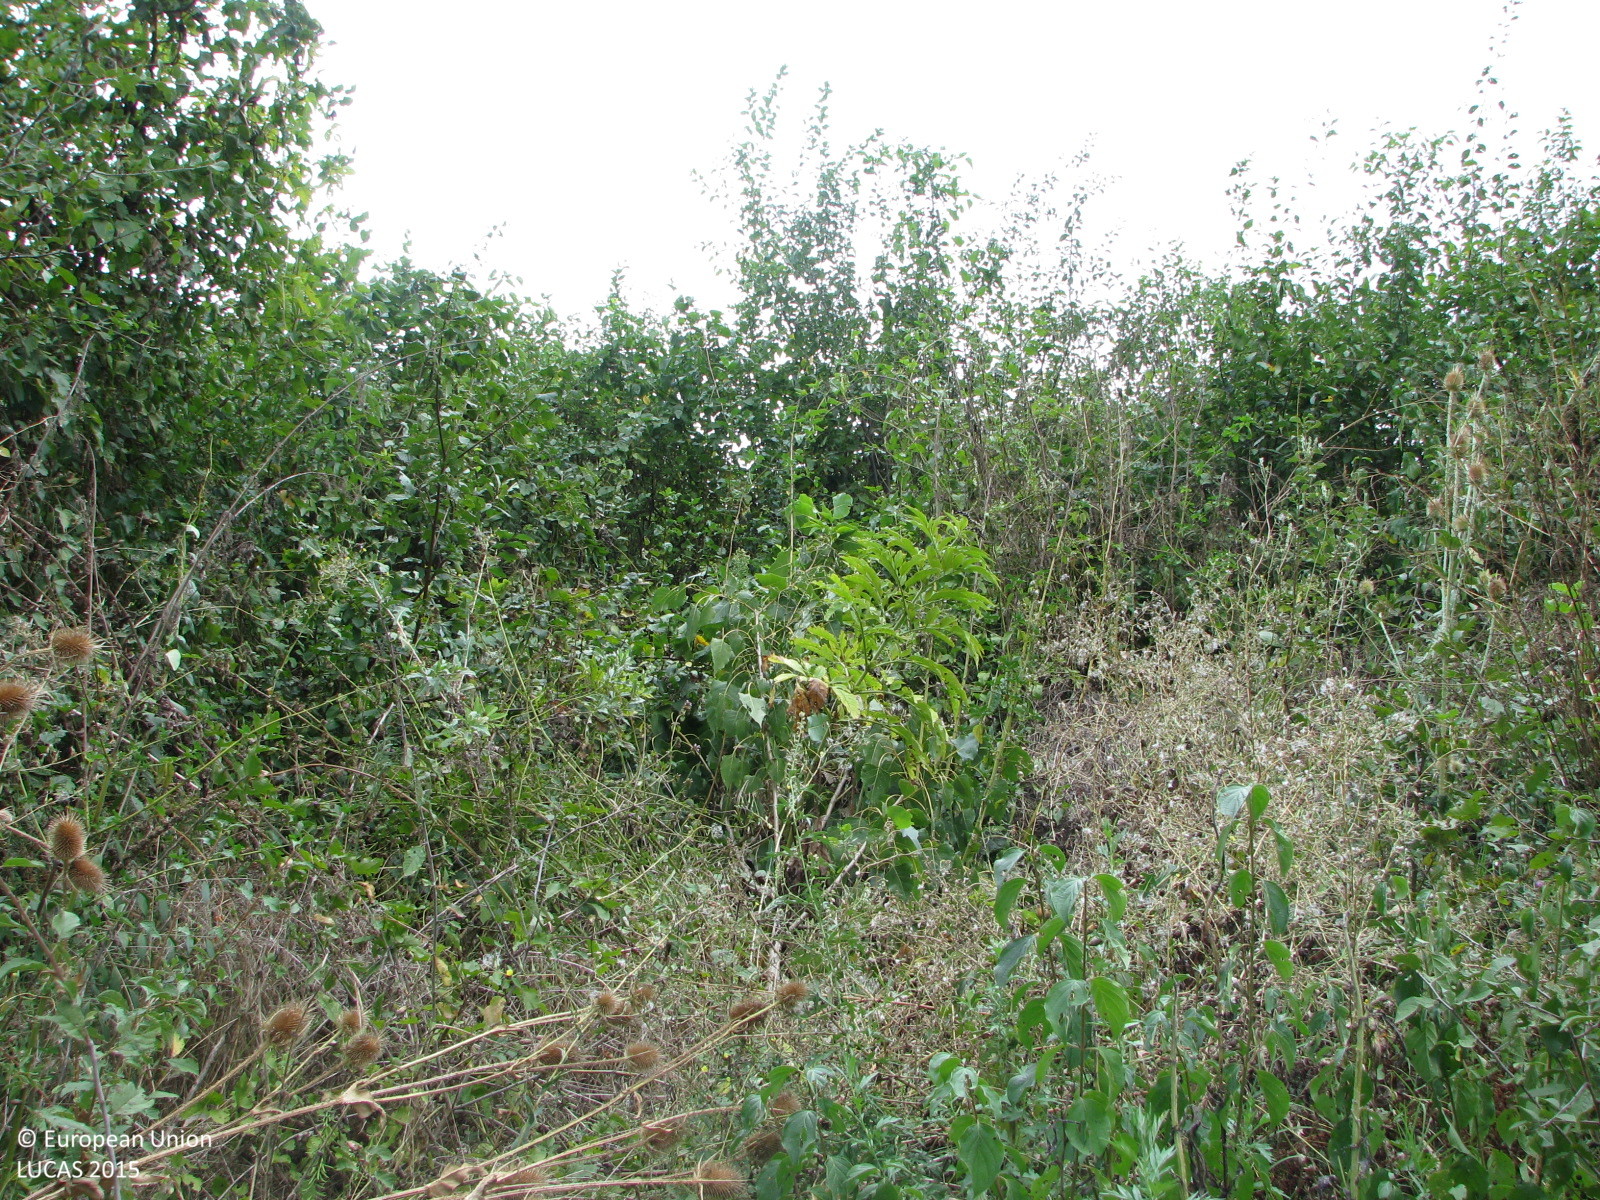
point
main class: Woodland
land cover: Broadleaved woodland
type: mesophytic deciduous forest
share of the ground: > 75 %
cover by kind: broadleaved forest trees 100 %
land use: Forestry
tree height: > 5 m
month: September
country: BG
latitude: 42.5708
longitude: 26.4279
